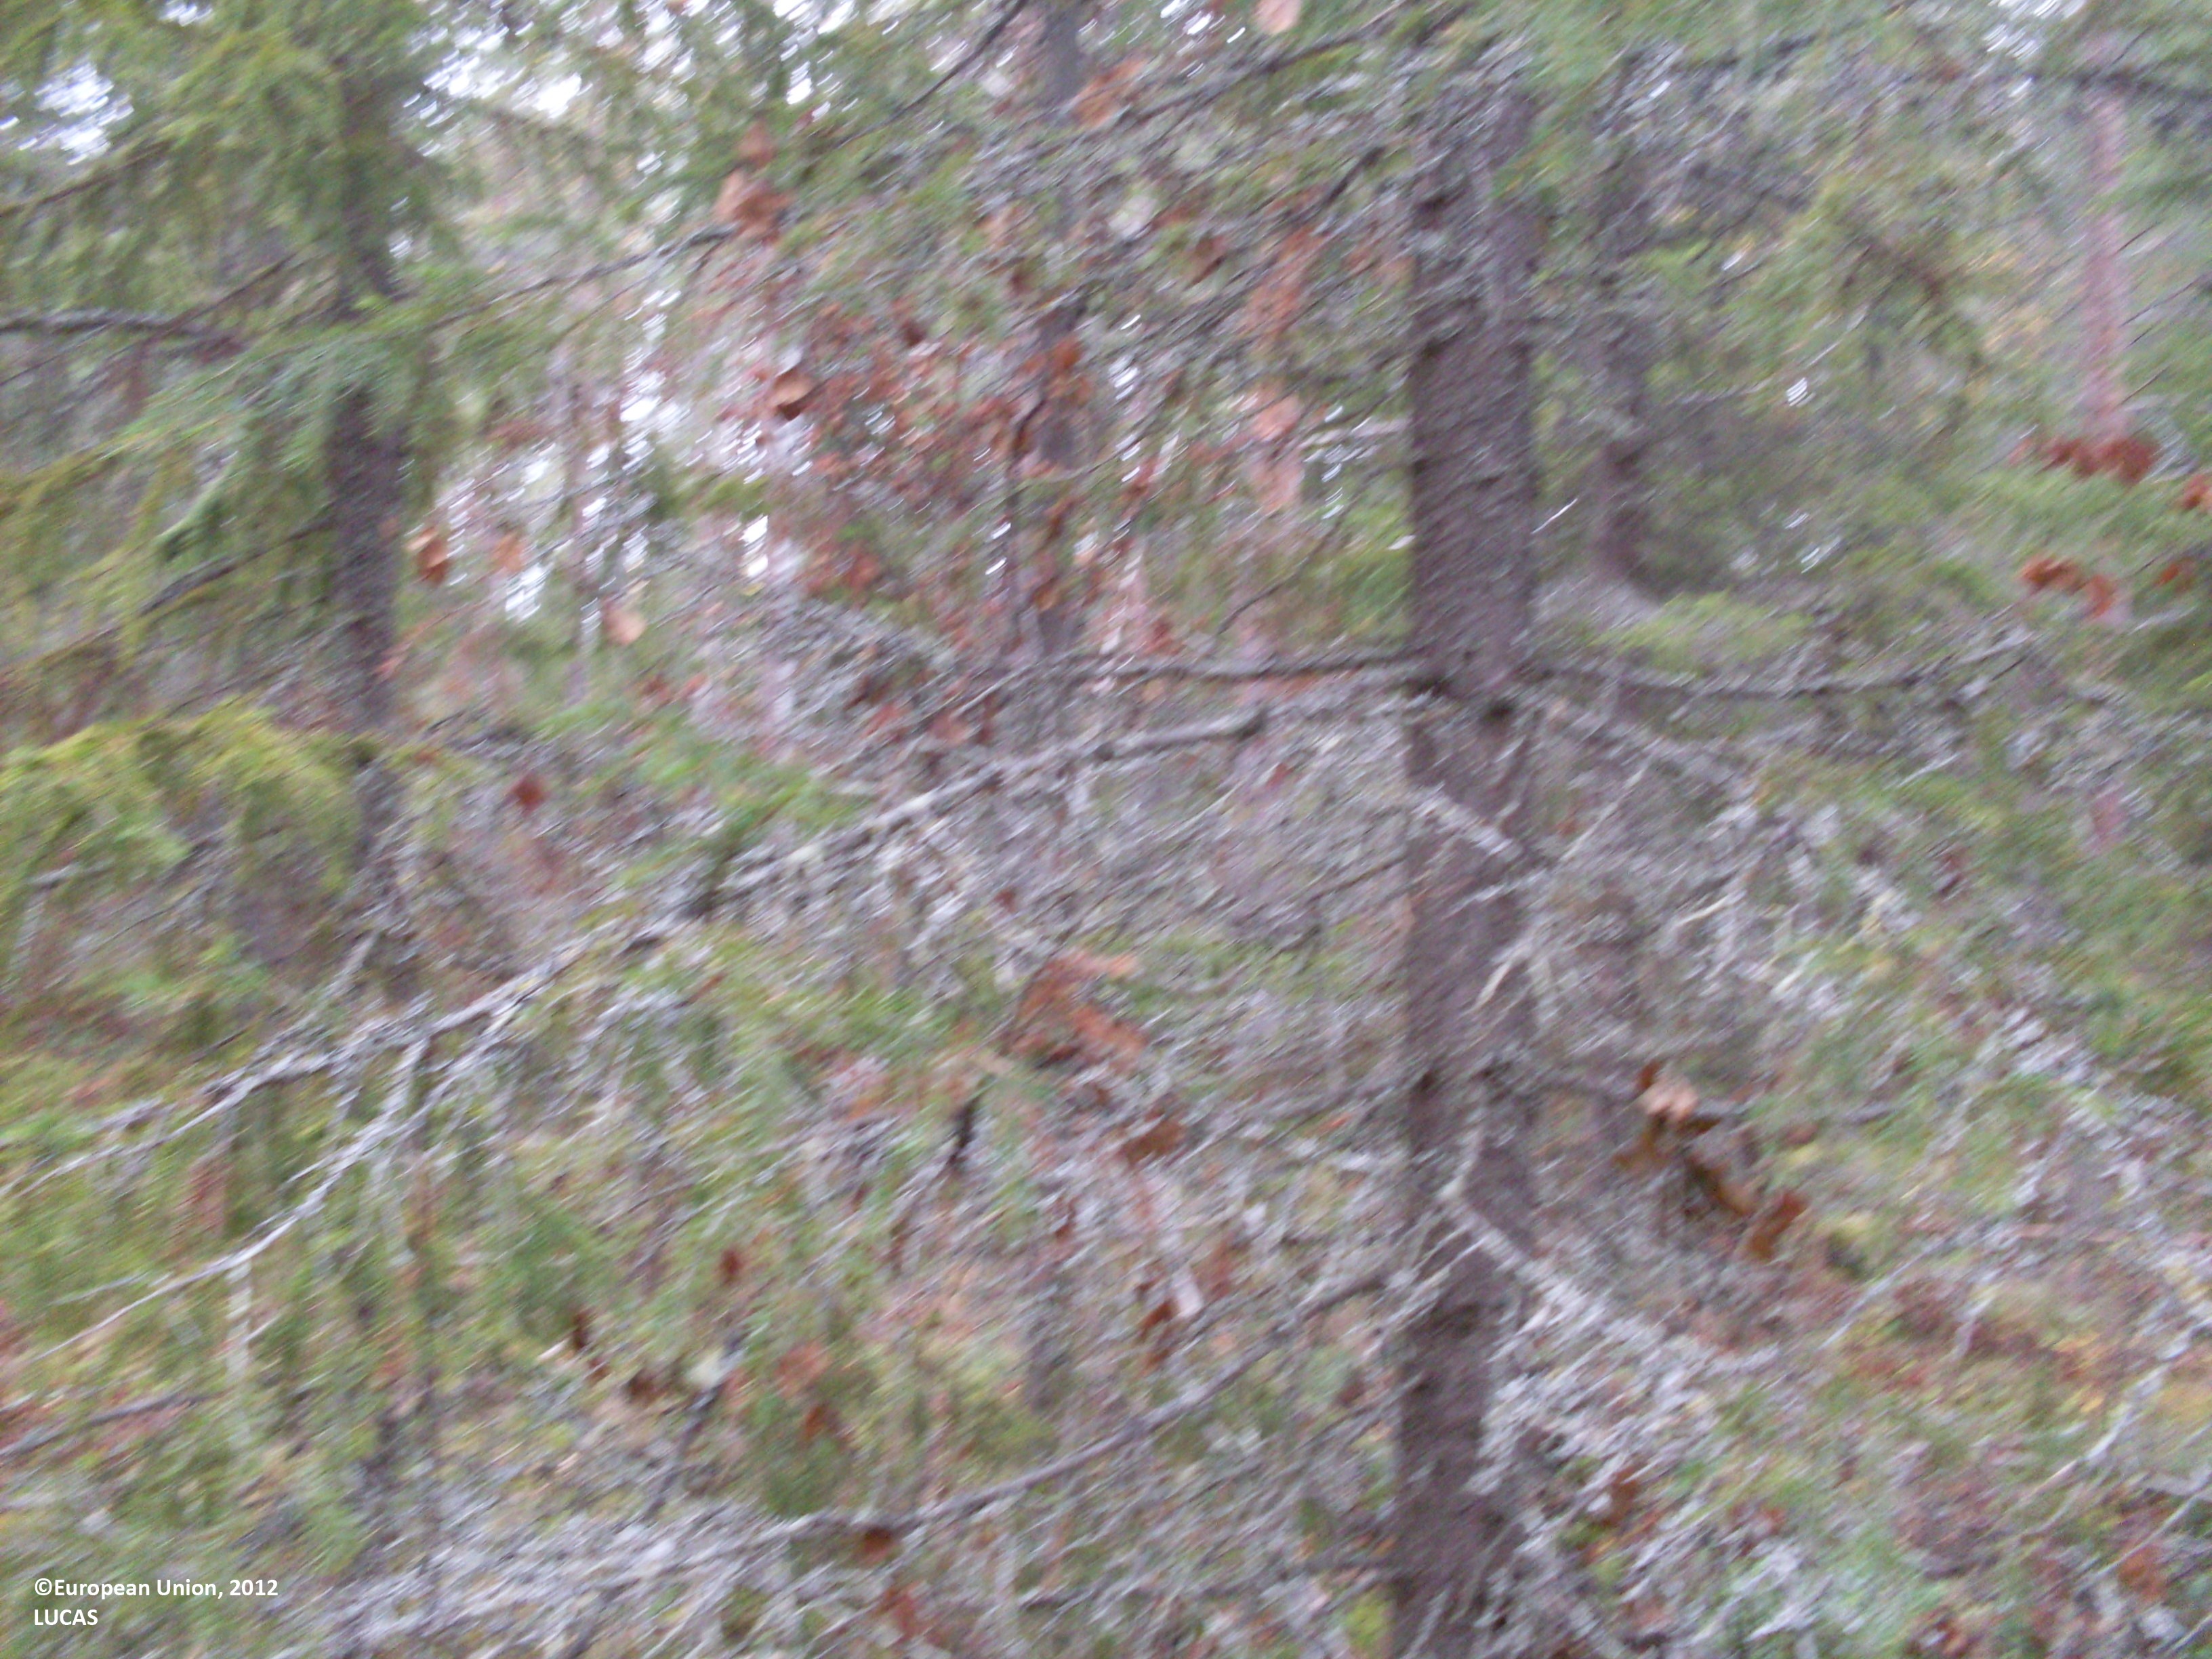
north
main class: Woodland
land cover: Spruce dominated mixed woodland
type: boreal forest
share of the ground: > 75 %
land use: Forestry
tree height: > 5 m
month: September
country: FI
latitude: 64.6767
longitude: 28.8127
